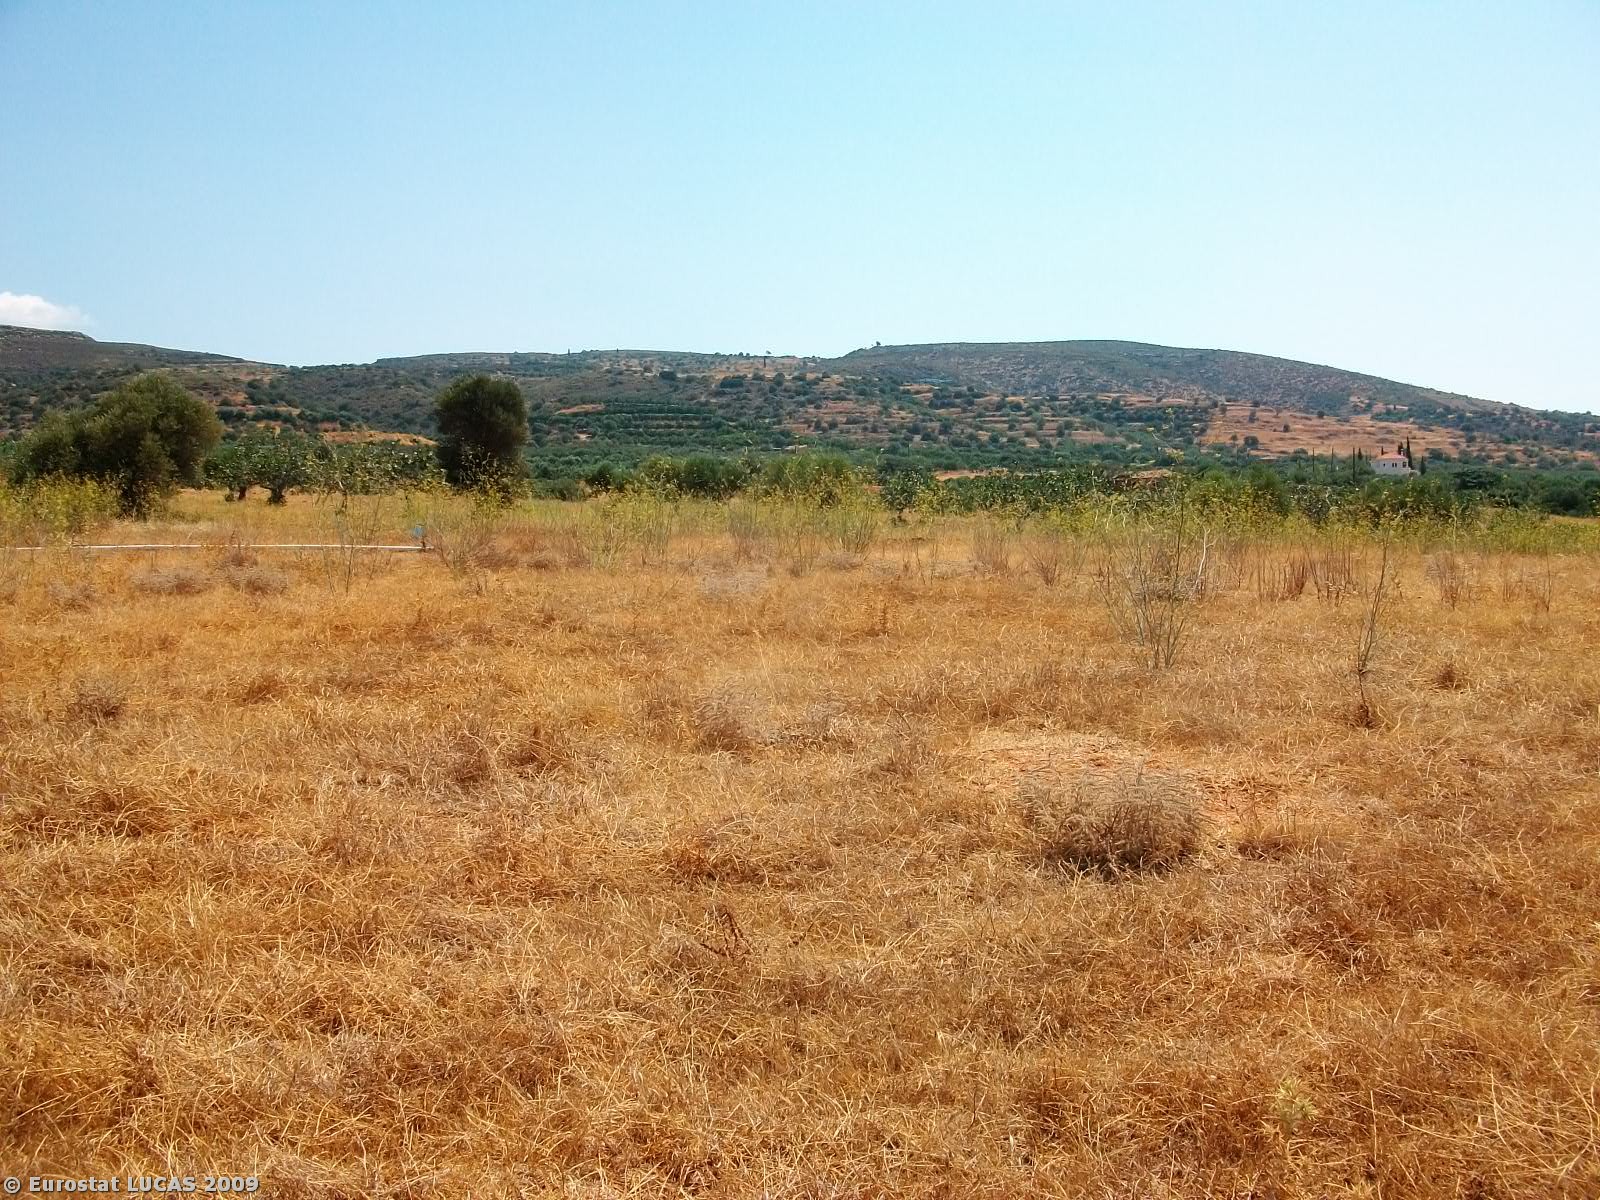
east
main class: Grassland
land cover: Grassland with sparse tree/shrub cover
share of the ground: > 75 %
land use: Agriculture (excluding fallow land and kitchen gardens)
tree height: < 5 m
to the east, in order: Grassland with sparse tree/shrub cover; Tracks; Grass margins; Paved roads, cycling and walking lanes; Grassland with sparse tree/shrub cover; Olive groves; Grassland with sparse tree/shrub cover; Shrubland with sparse tree cover; Olive groves; Grassland with sparse tree/shrub cover; Grassland without tree/shrub cover; Tracks; Olive groves; Grassland with sparse tree/shrub cover
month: August
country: GR
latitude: 36.7681
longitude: 22.8038
